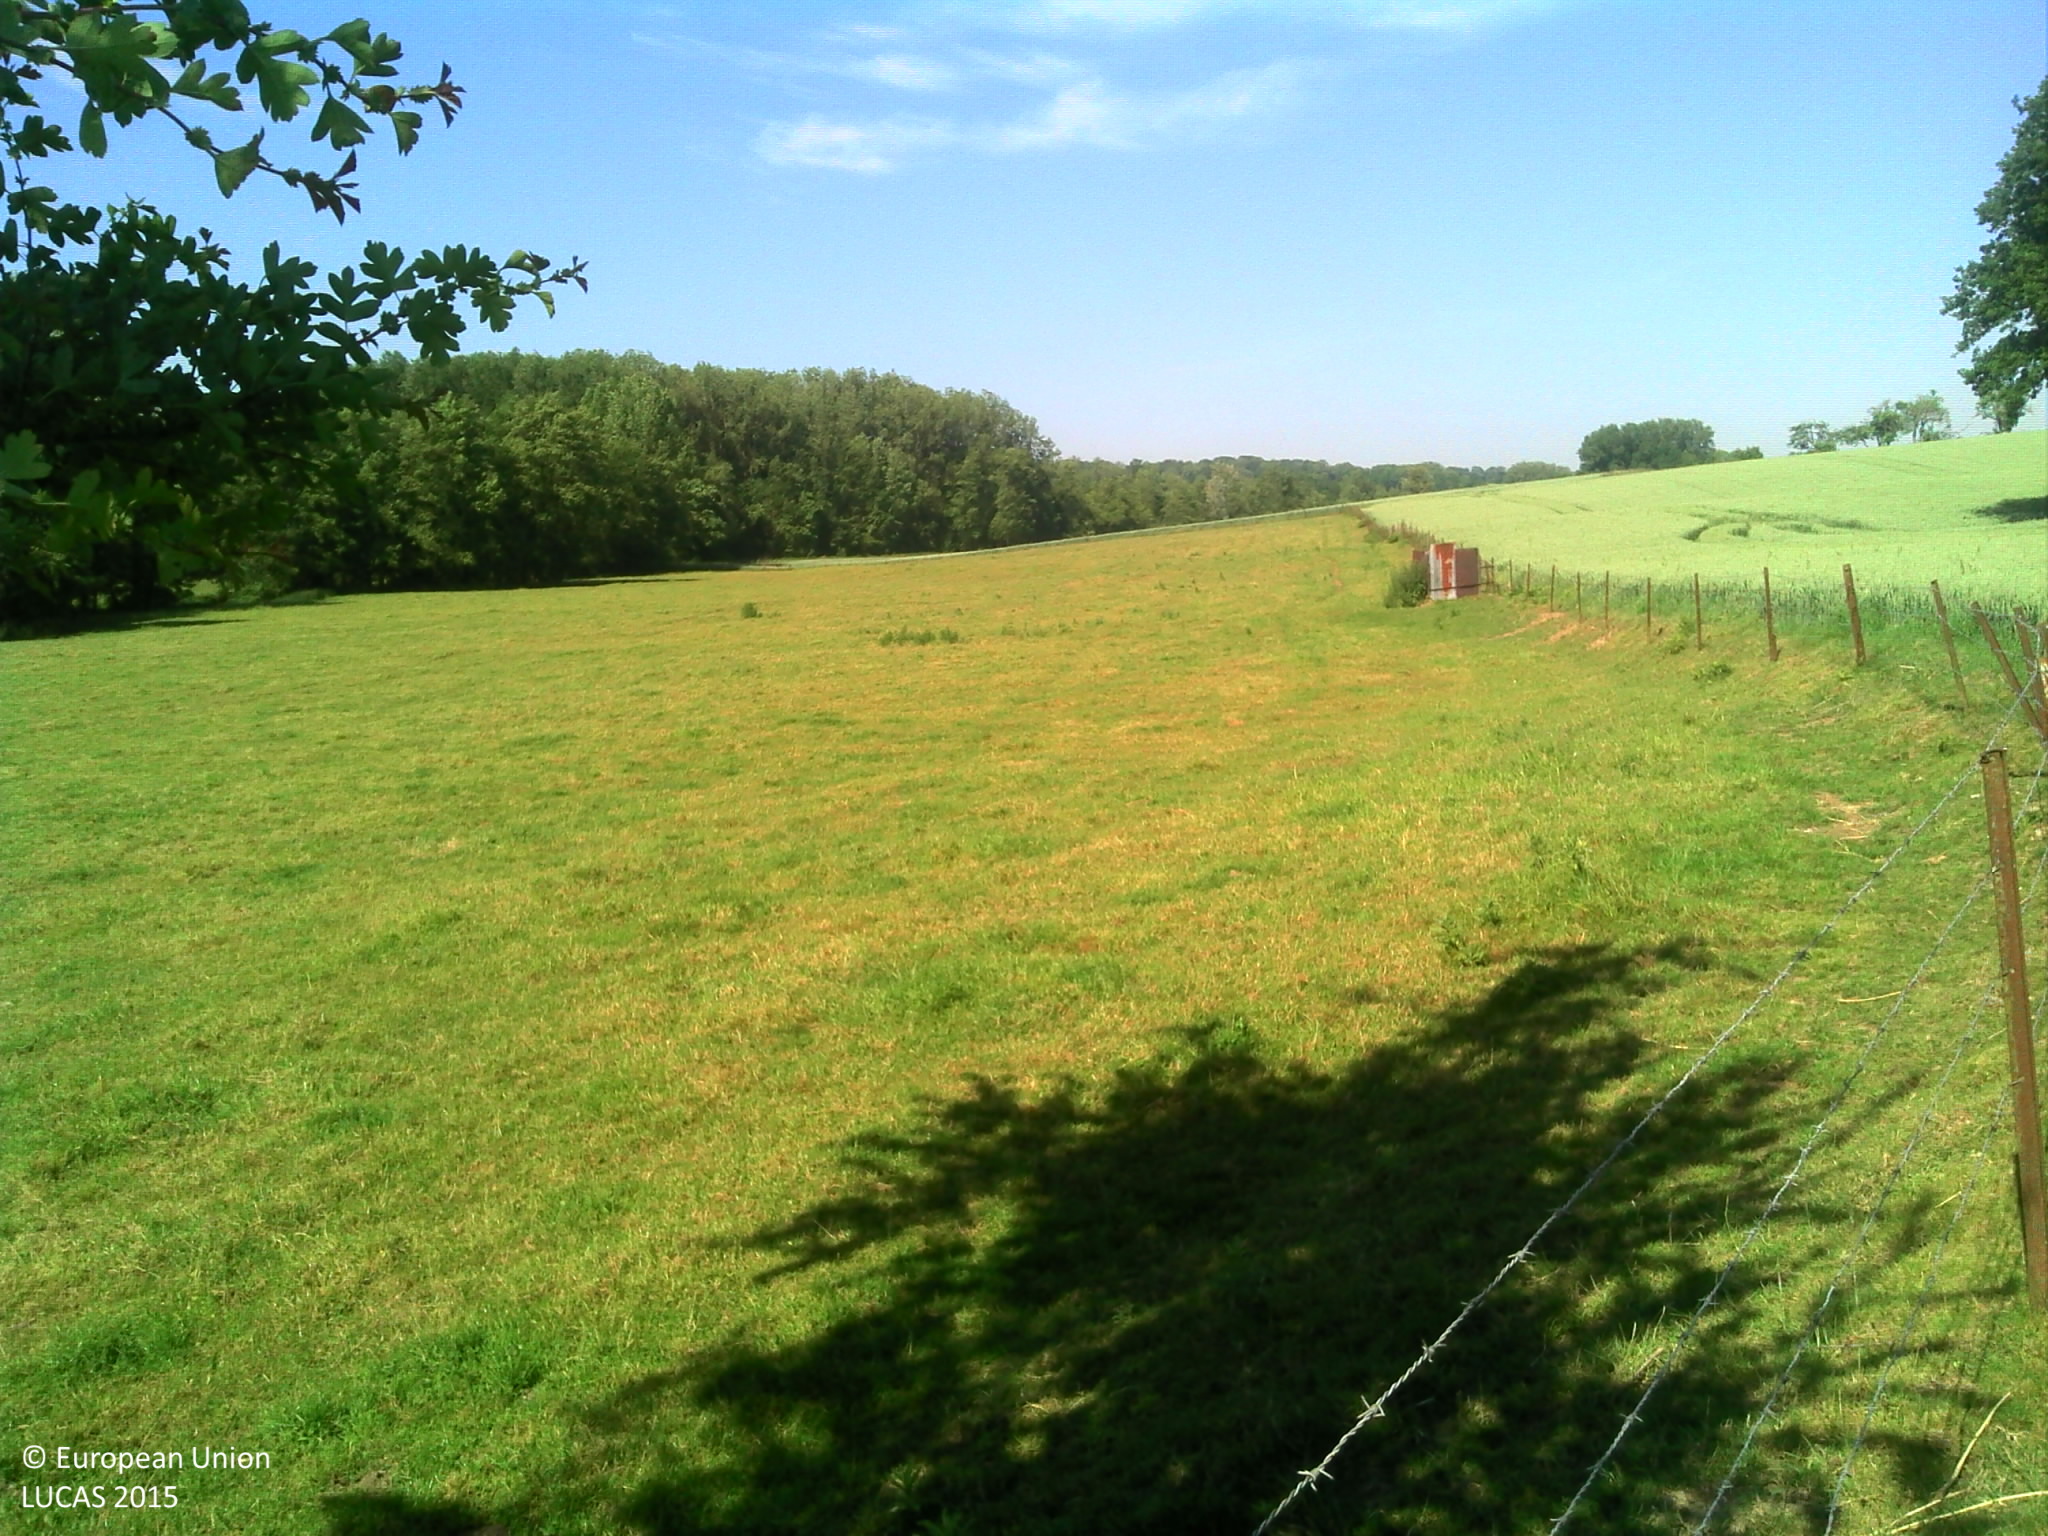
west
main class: Cropland
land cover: Common wheat
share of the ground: > 75 %
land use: Agriculture (excluding fallow land and kitchen gardens)
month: June
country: FR
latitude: 49.7758
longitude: 4.0374
